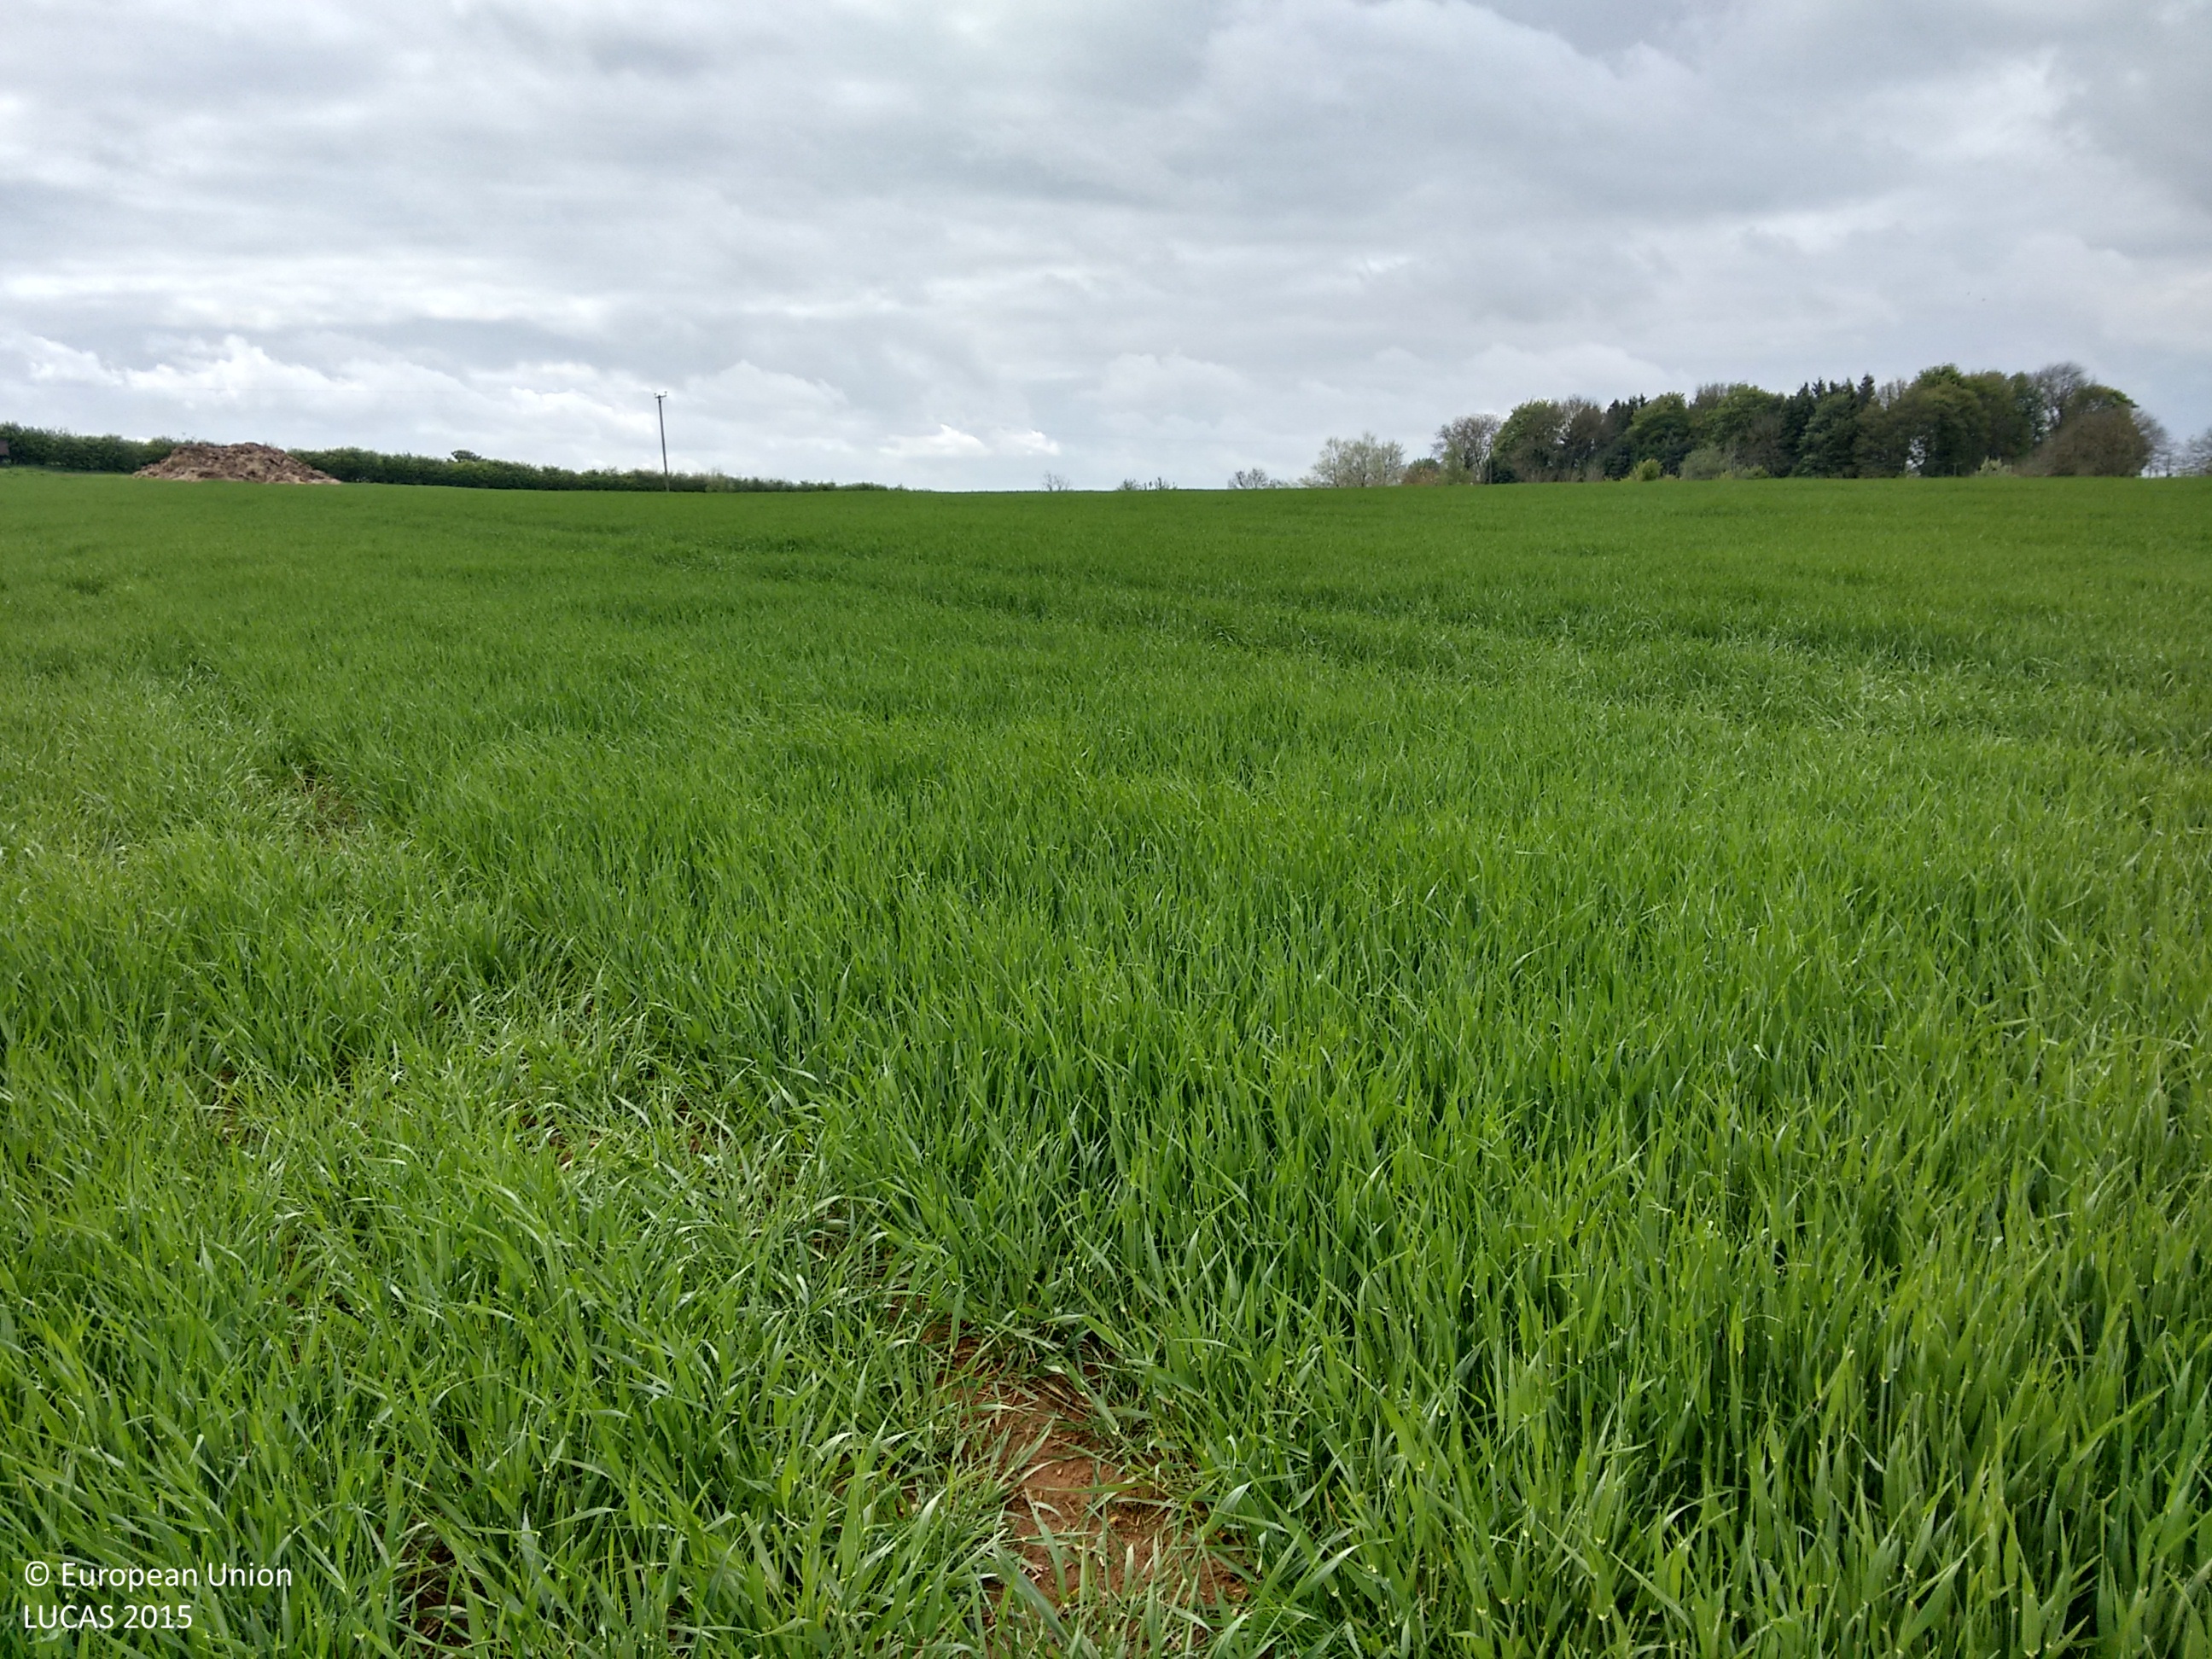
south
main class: Cropland
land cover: Barley
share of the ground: > 75 %
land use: Agriculture (excluding fallow land and kitchen gardens)
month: May
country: GB
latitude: 53.3377
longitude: -0.1406
